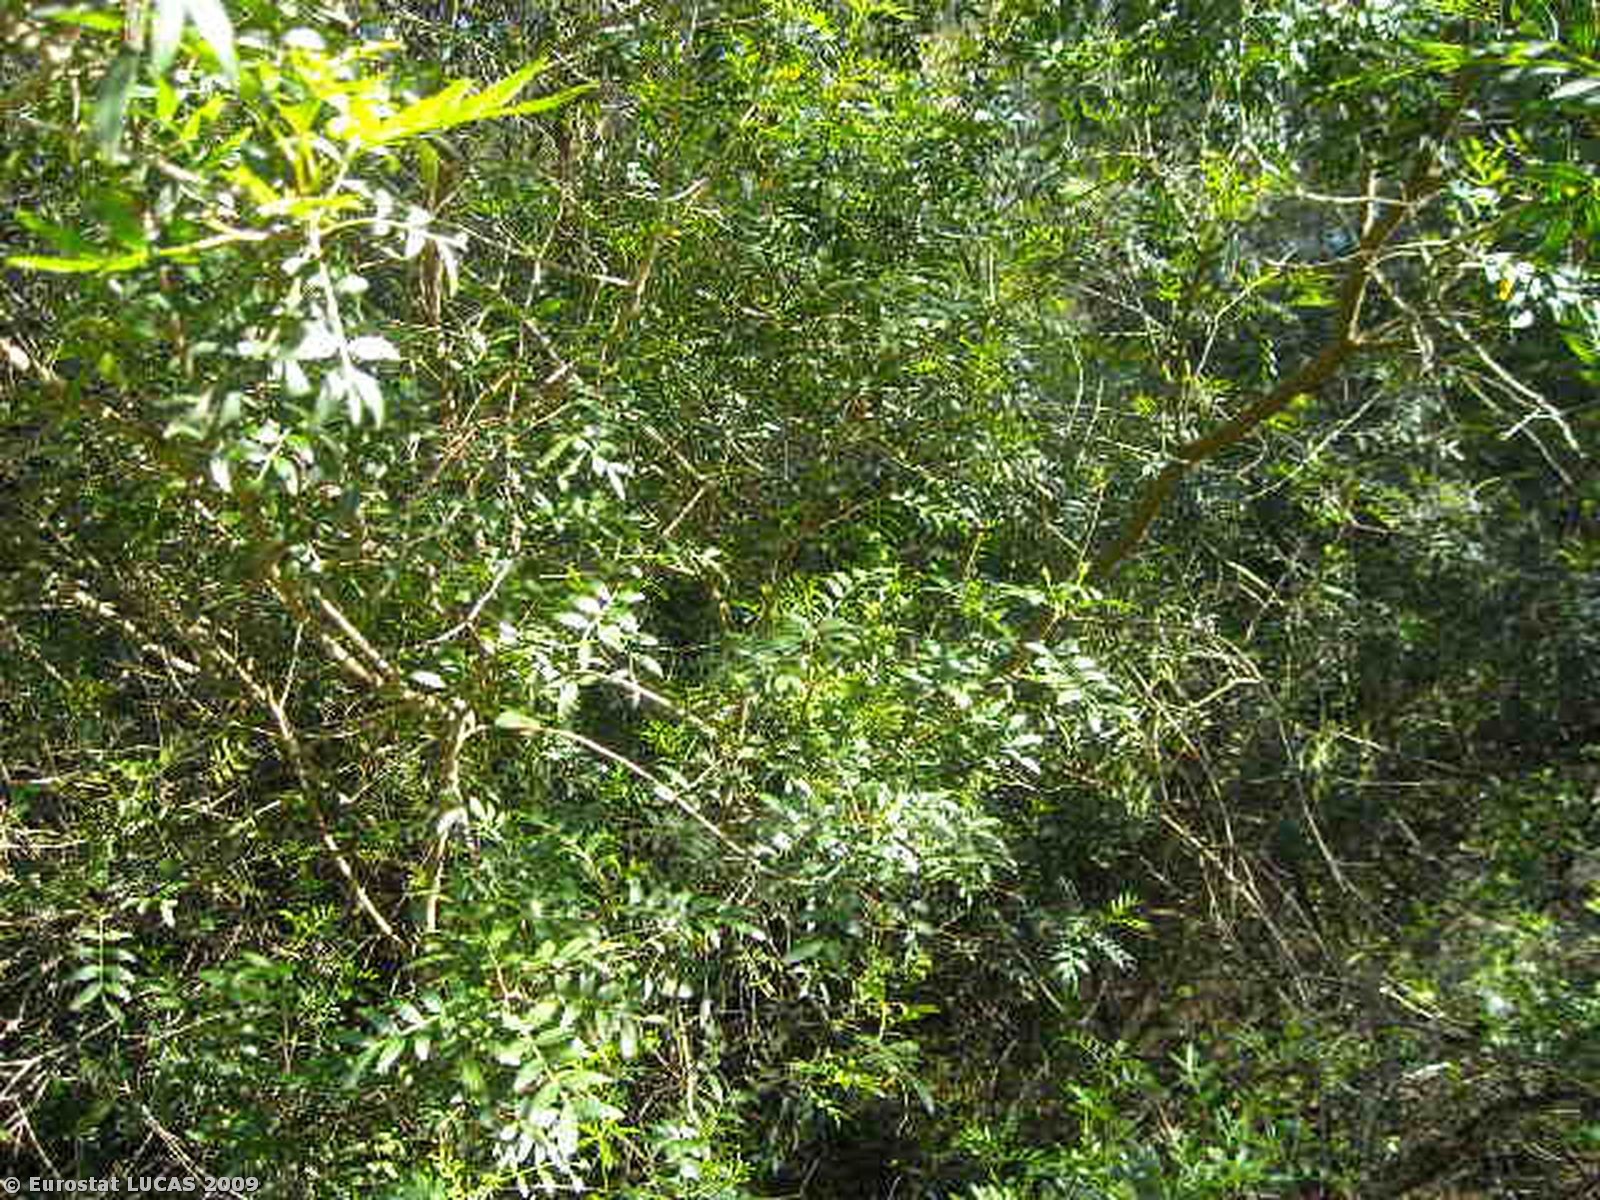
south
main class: Woodland
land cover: Coniferous woodland
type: coniferous forest of the mediterranean region
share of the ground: > 75 %
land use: Nature reserves
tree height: > 5 m
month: May
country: IT
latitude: 40.4421
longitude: 16.8959
